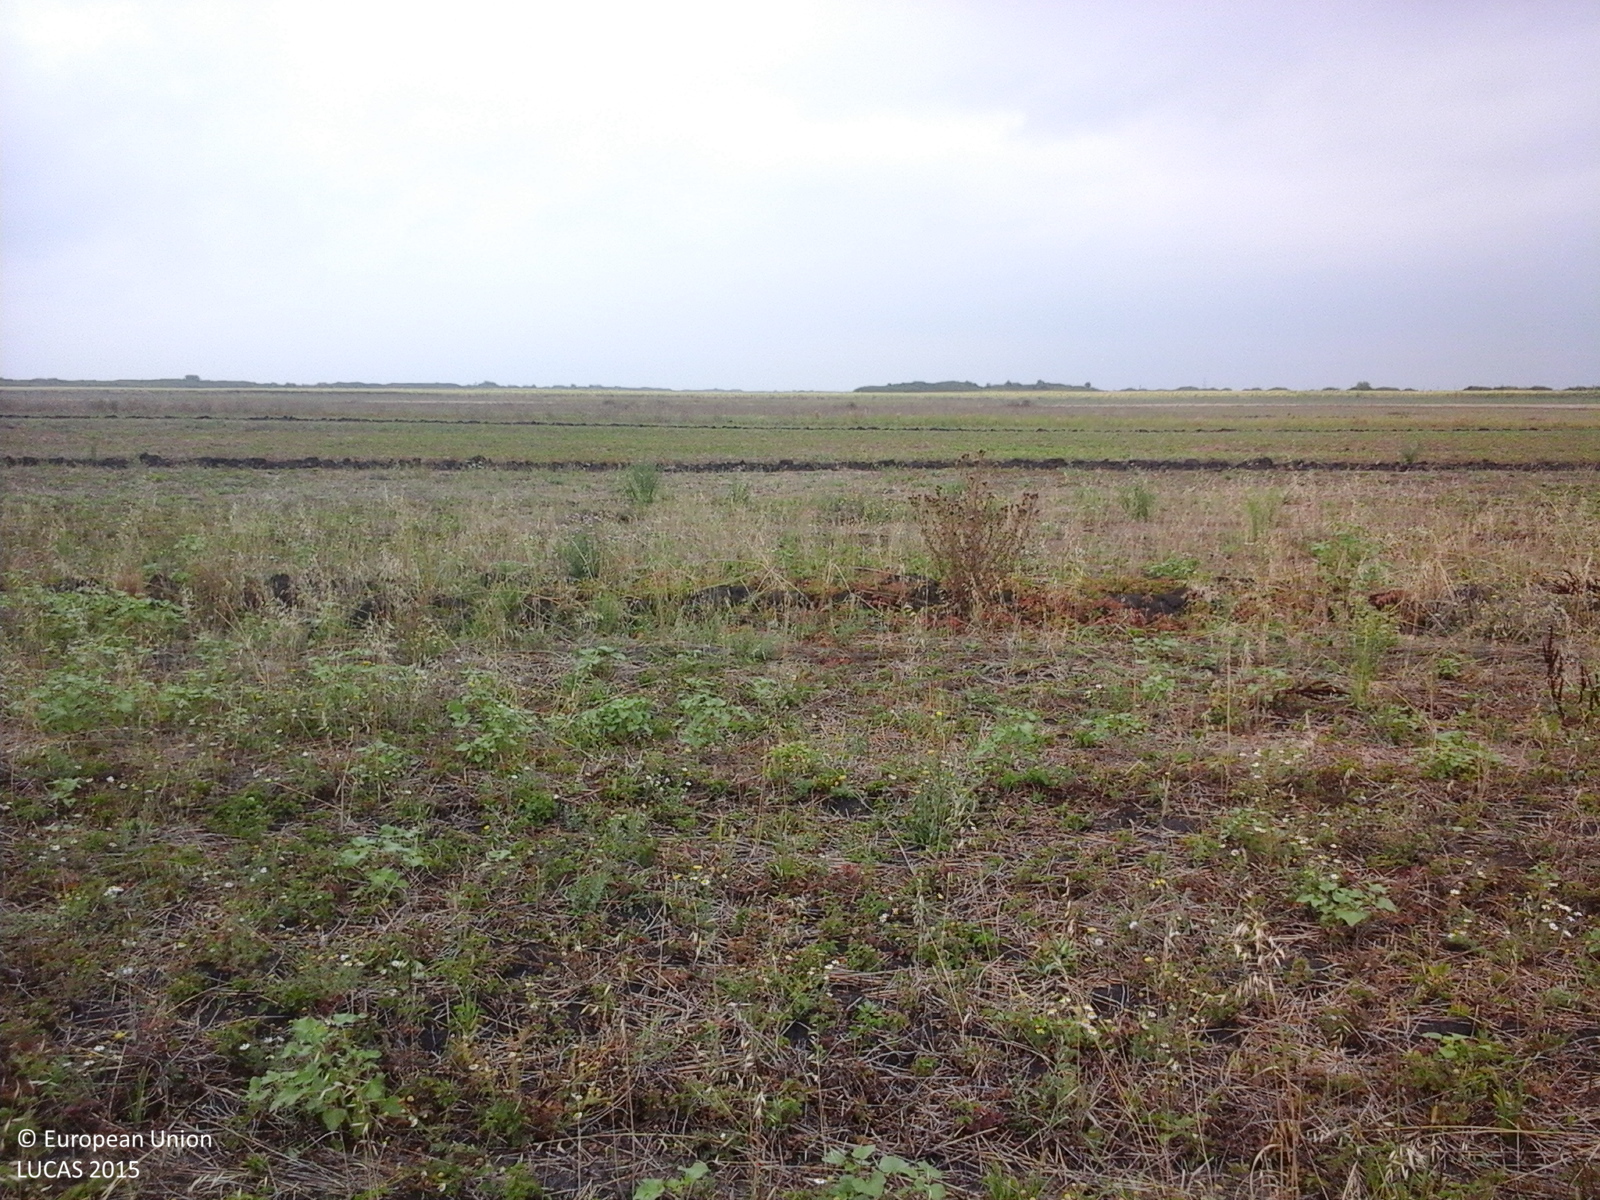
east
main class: Cropland
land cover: Sunflower
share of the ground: > 75 %
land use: Agriculture (excluding fallow land and kitchen gardens)
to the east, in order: Sunflower; Spontaneously vegetated surfaces; Common wheat; Spontaneously vegetated surfaces; Common wheat; Spontaneously vegetated surfaces
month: August
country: RO
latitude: 46.1316
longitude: 20.4173
